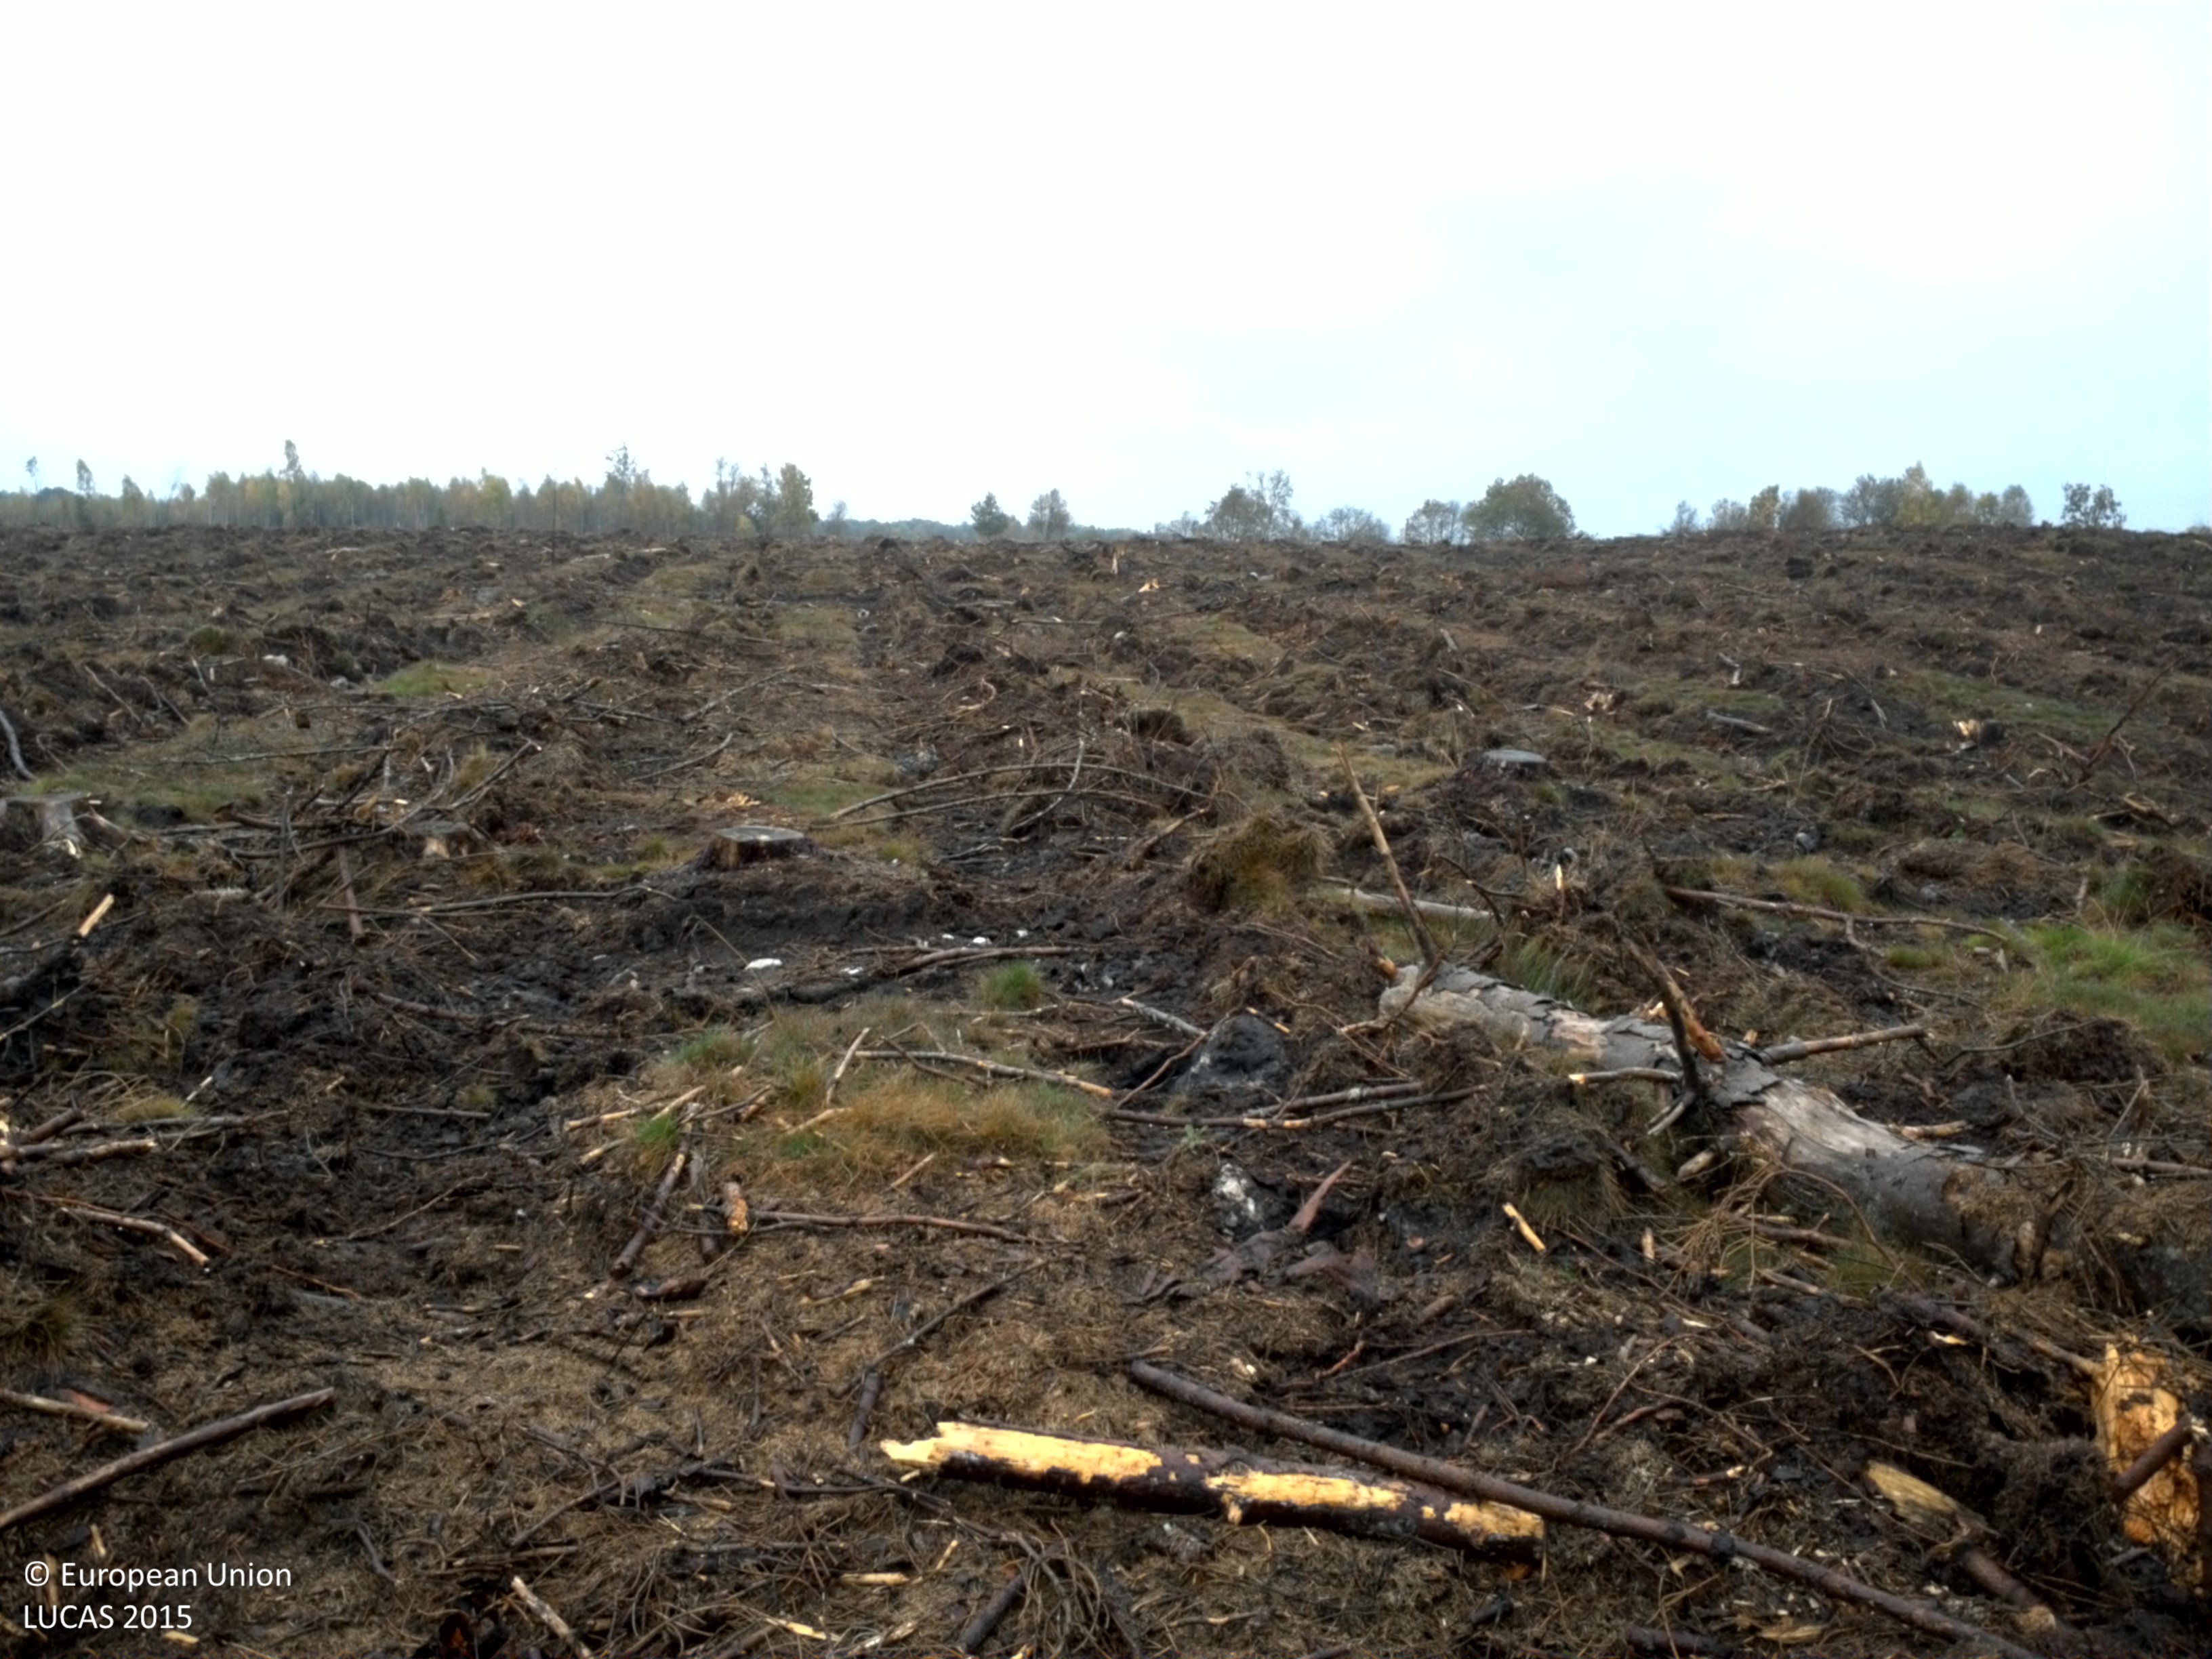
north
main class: Grassland
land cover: Grassland without tree/shrub cover
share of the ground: 10 - 25 %
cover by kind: unconsolidated bare surface 40 %, herbaceous plants 15 %
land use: Forestry
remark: Clear cut
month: October
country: SE
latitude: 55.7296
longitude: 13.9951
